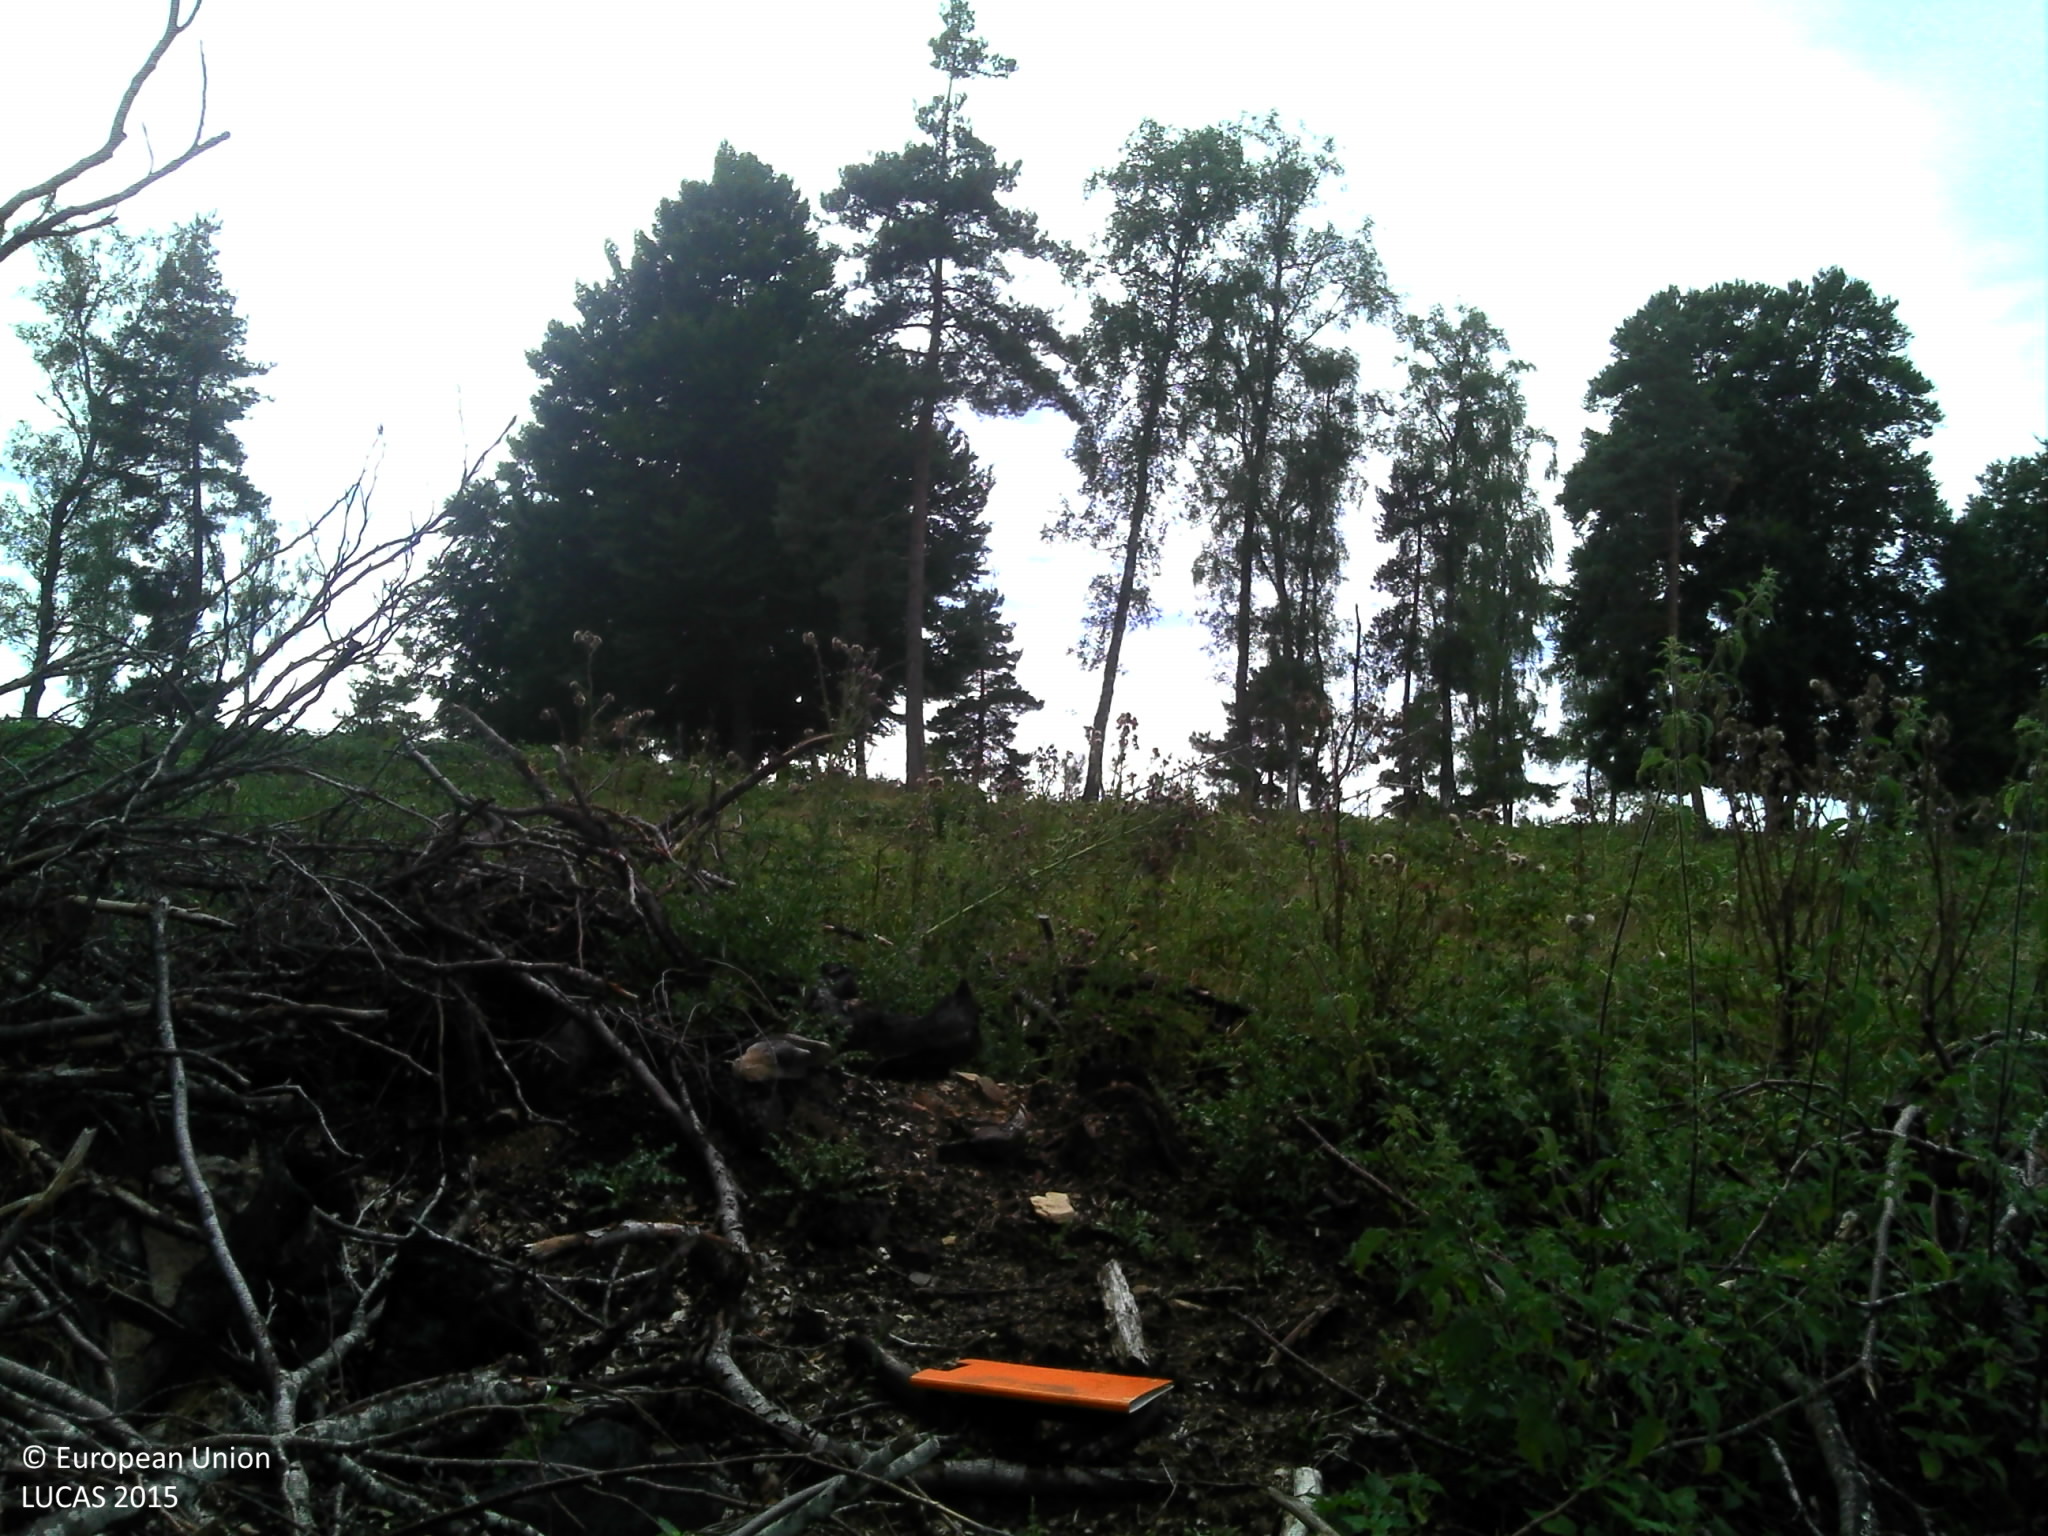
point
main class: Grassland
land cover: Grassland with sparse tree/shrub cover
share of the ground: > 75 %
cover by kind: herbaceous plants 85 %, shrubs 10 %, broadleaved forest trees 5 %
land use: Agriculture (excluding fallow land and kitchen gardens)
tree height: < 5 m
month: July
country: FR
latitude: 44.8842
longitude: 3.1537
